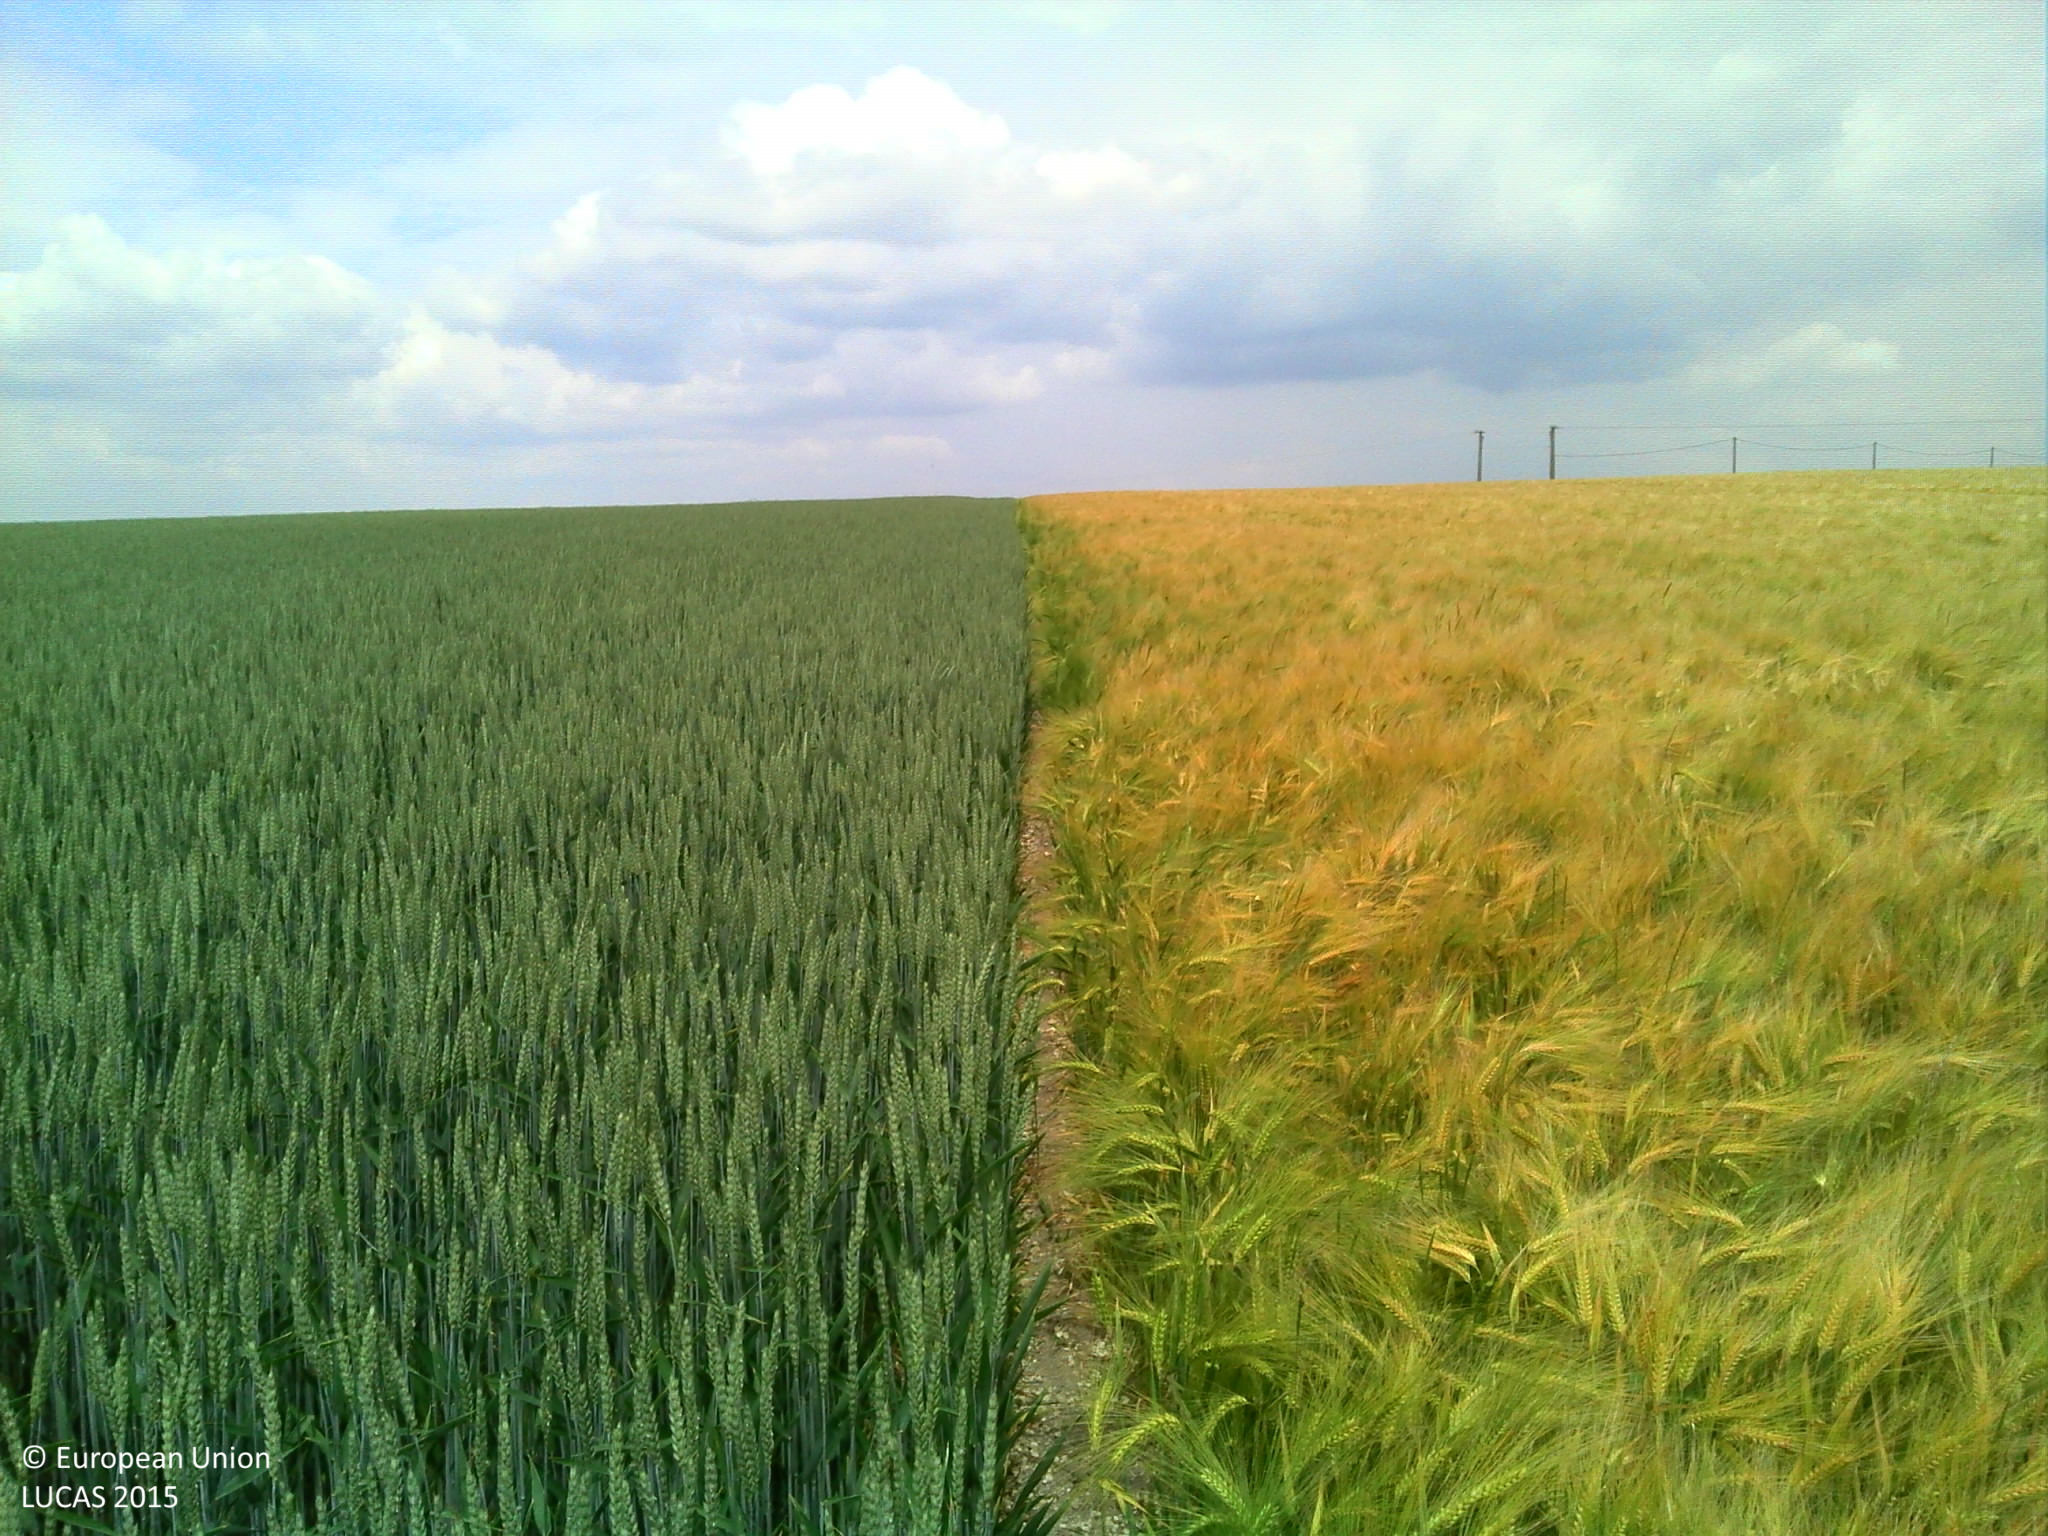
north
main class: Cropland
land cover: Barley
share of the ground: > 75 %
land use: Agriculture (excluding fallow land and kitchen gardens)
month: June
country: BE
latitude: 50.3892
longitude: 4.0448
